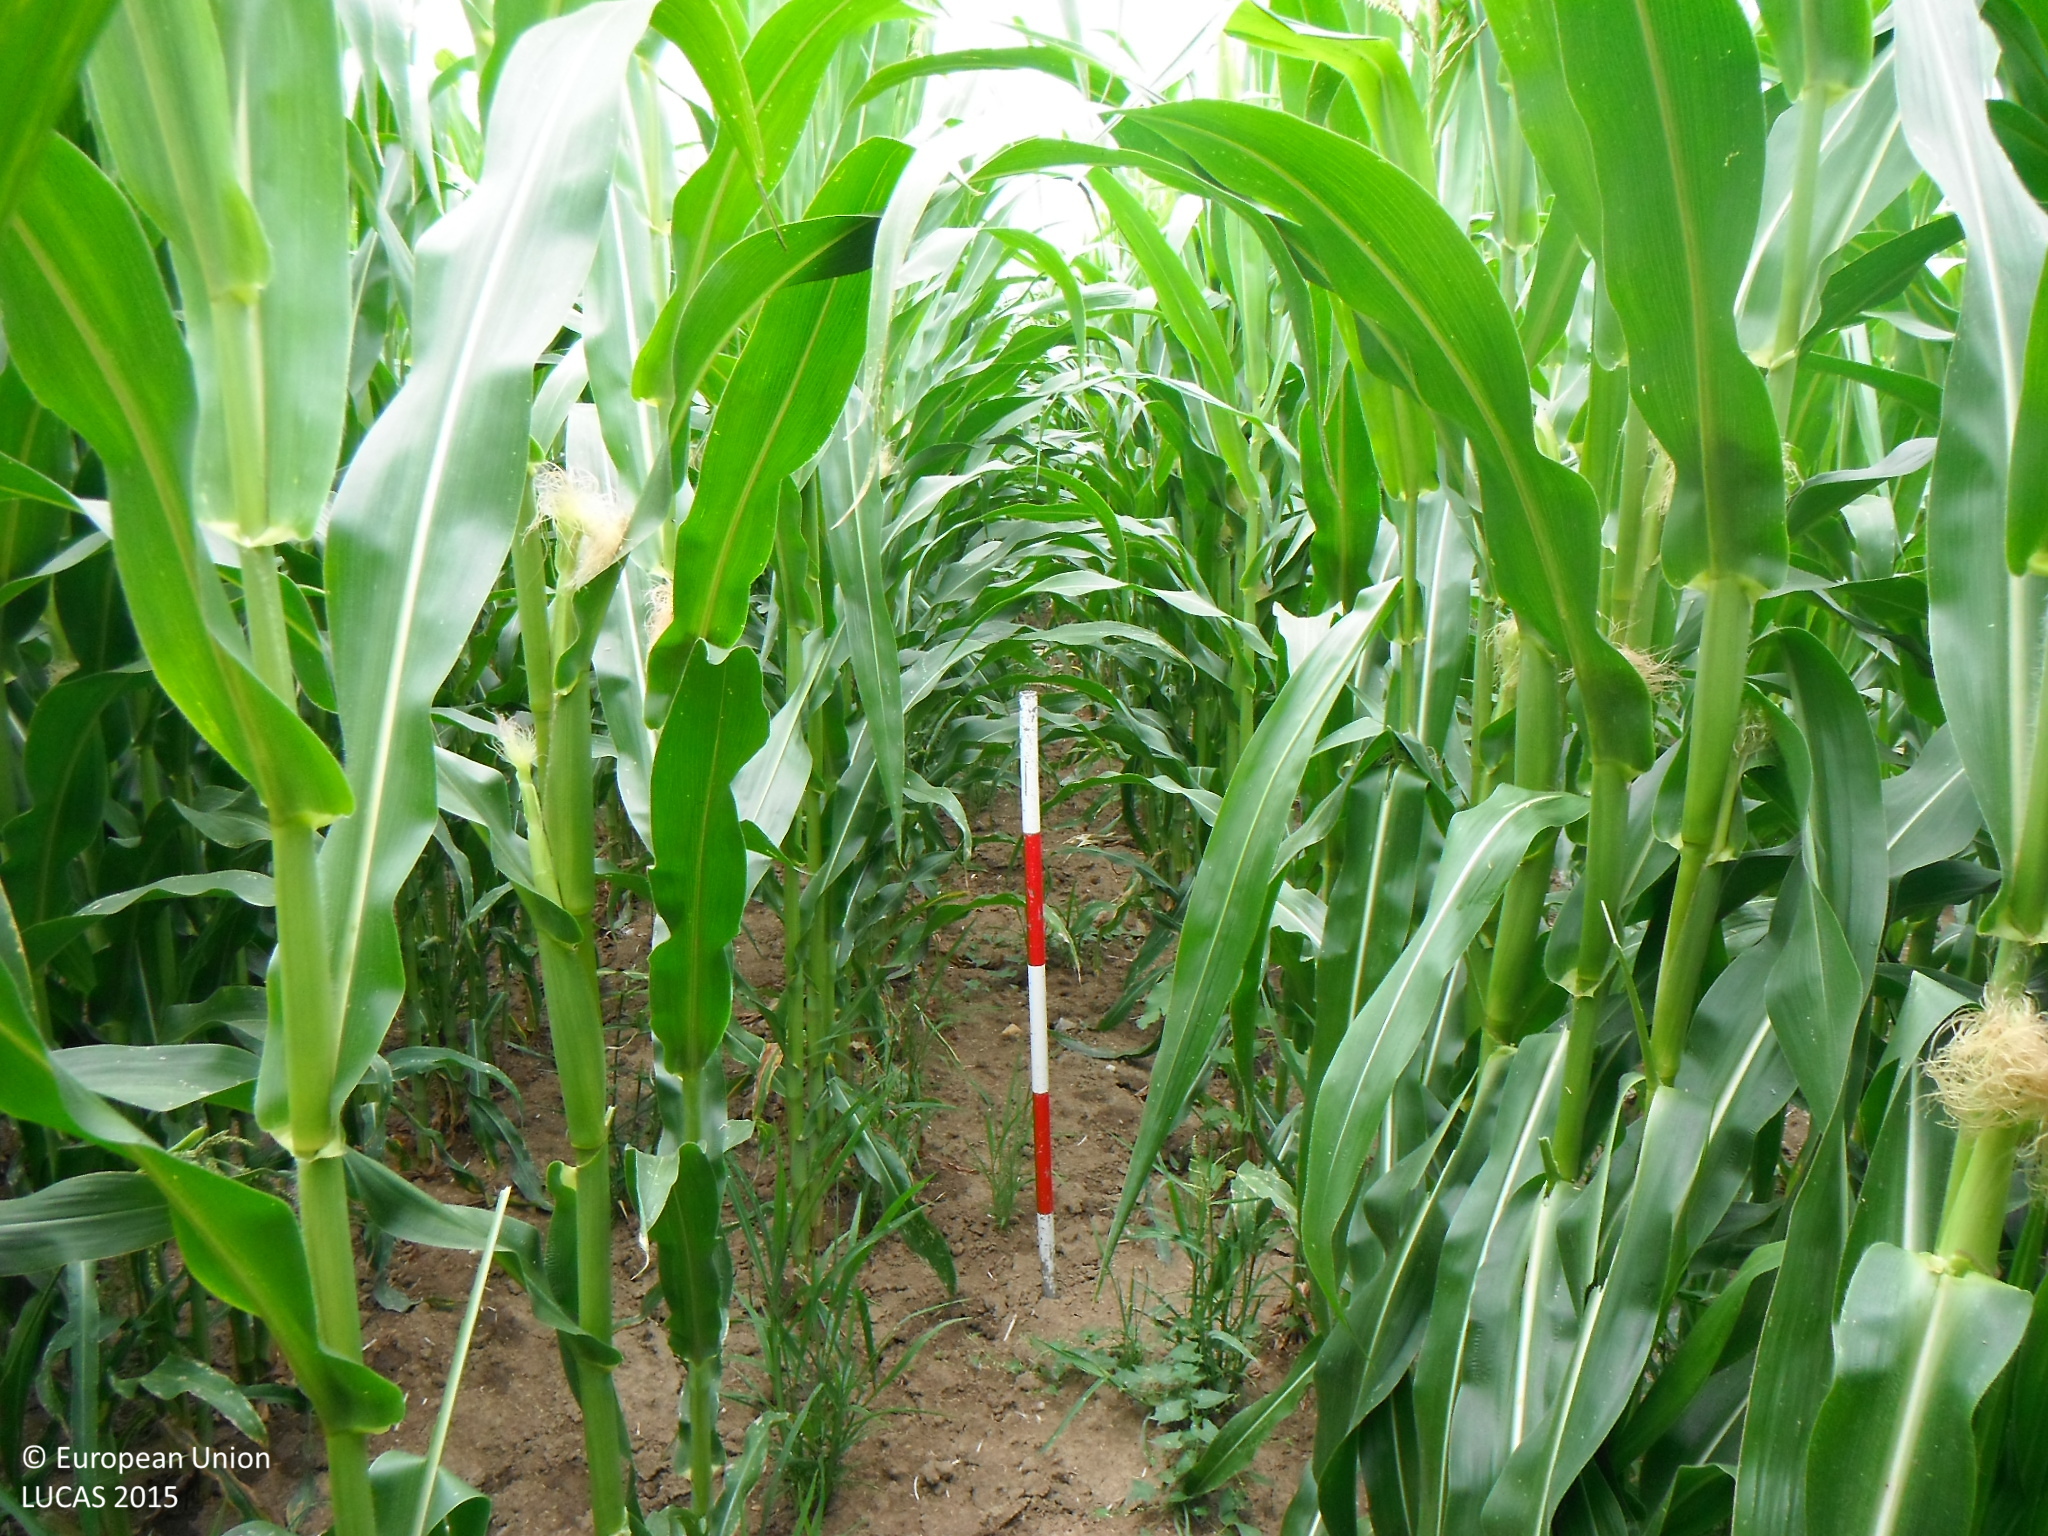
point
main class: Cropland
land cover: Maize
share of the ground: > 75 %
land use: Agriculture (excluding fallow land and kitchen gardens)
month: July
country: SK
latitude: 48.3029
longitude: 20.2914
